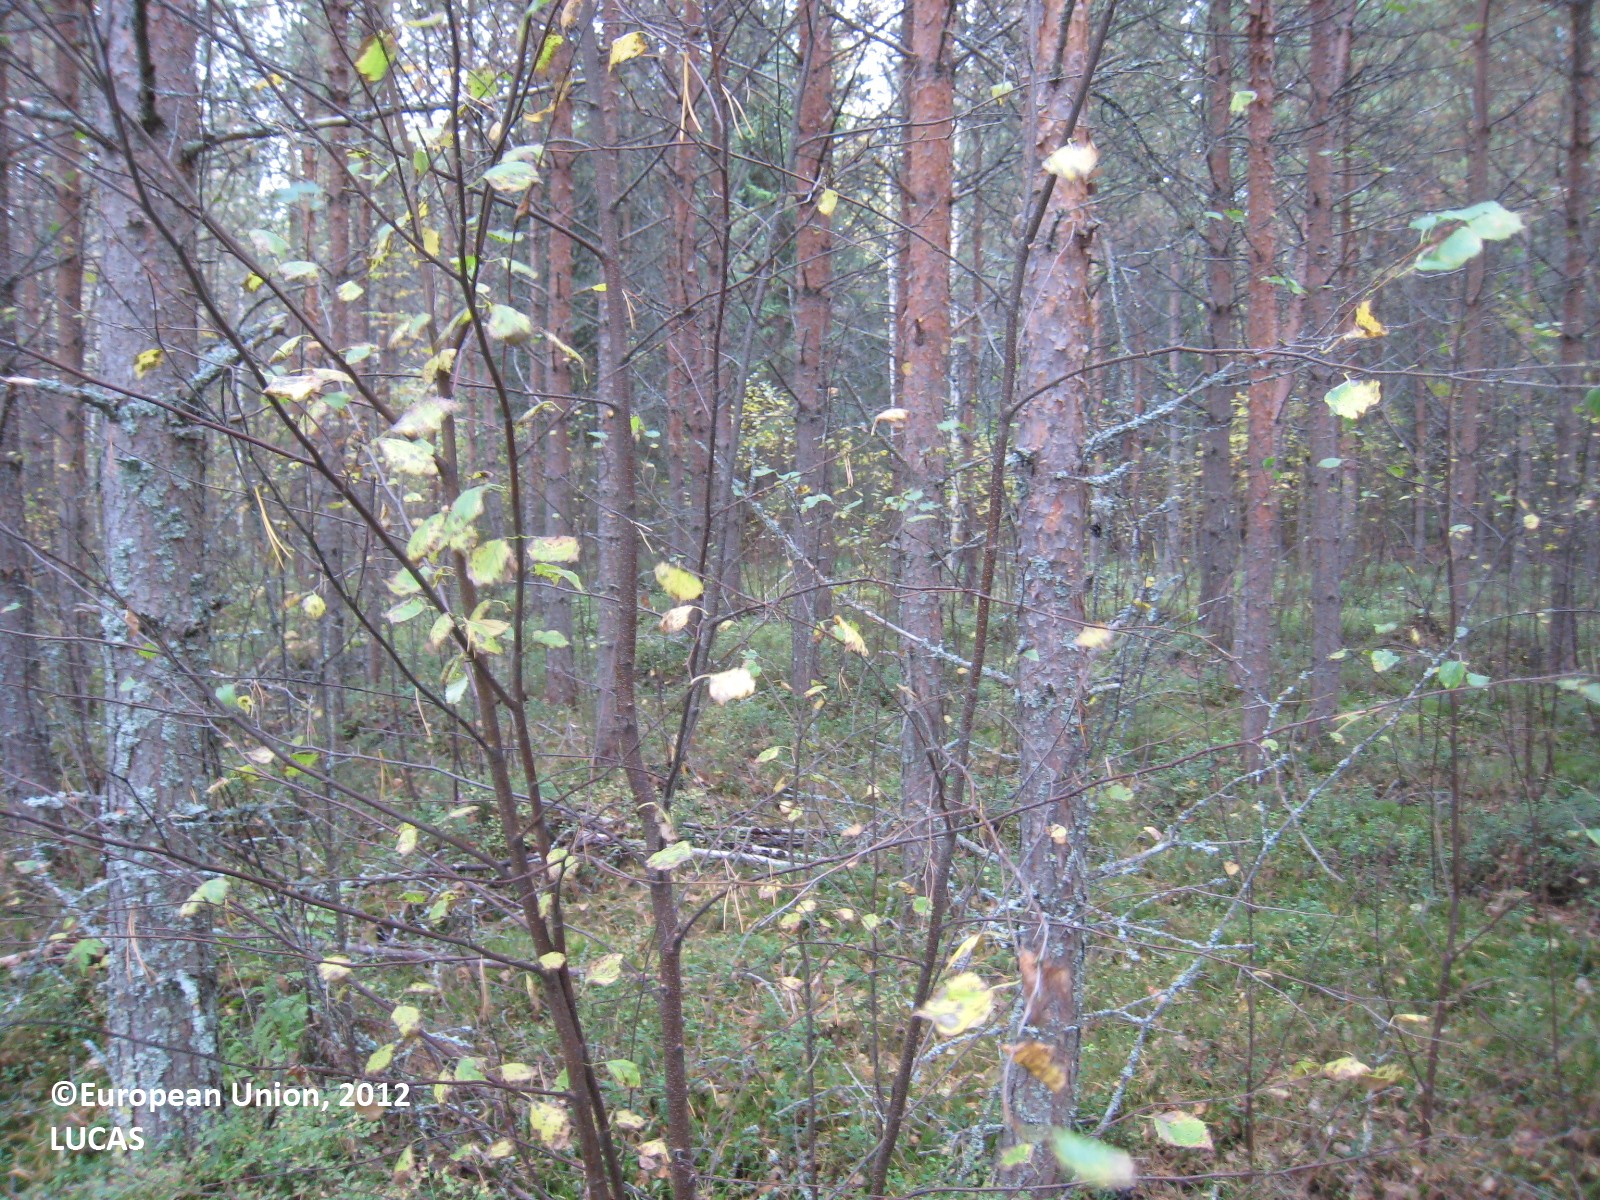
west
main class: Woodland
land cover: Pine dominated coniferous woodland
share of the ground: > 75 %
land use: Forestry
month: September
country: FI
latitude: 62.6932
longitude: 26.6501
